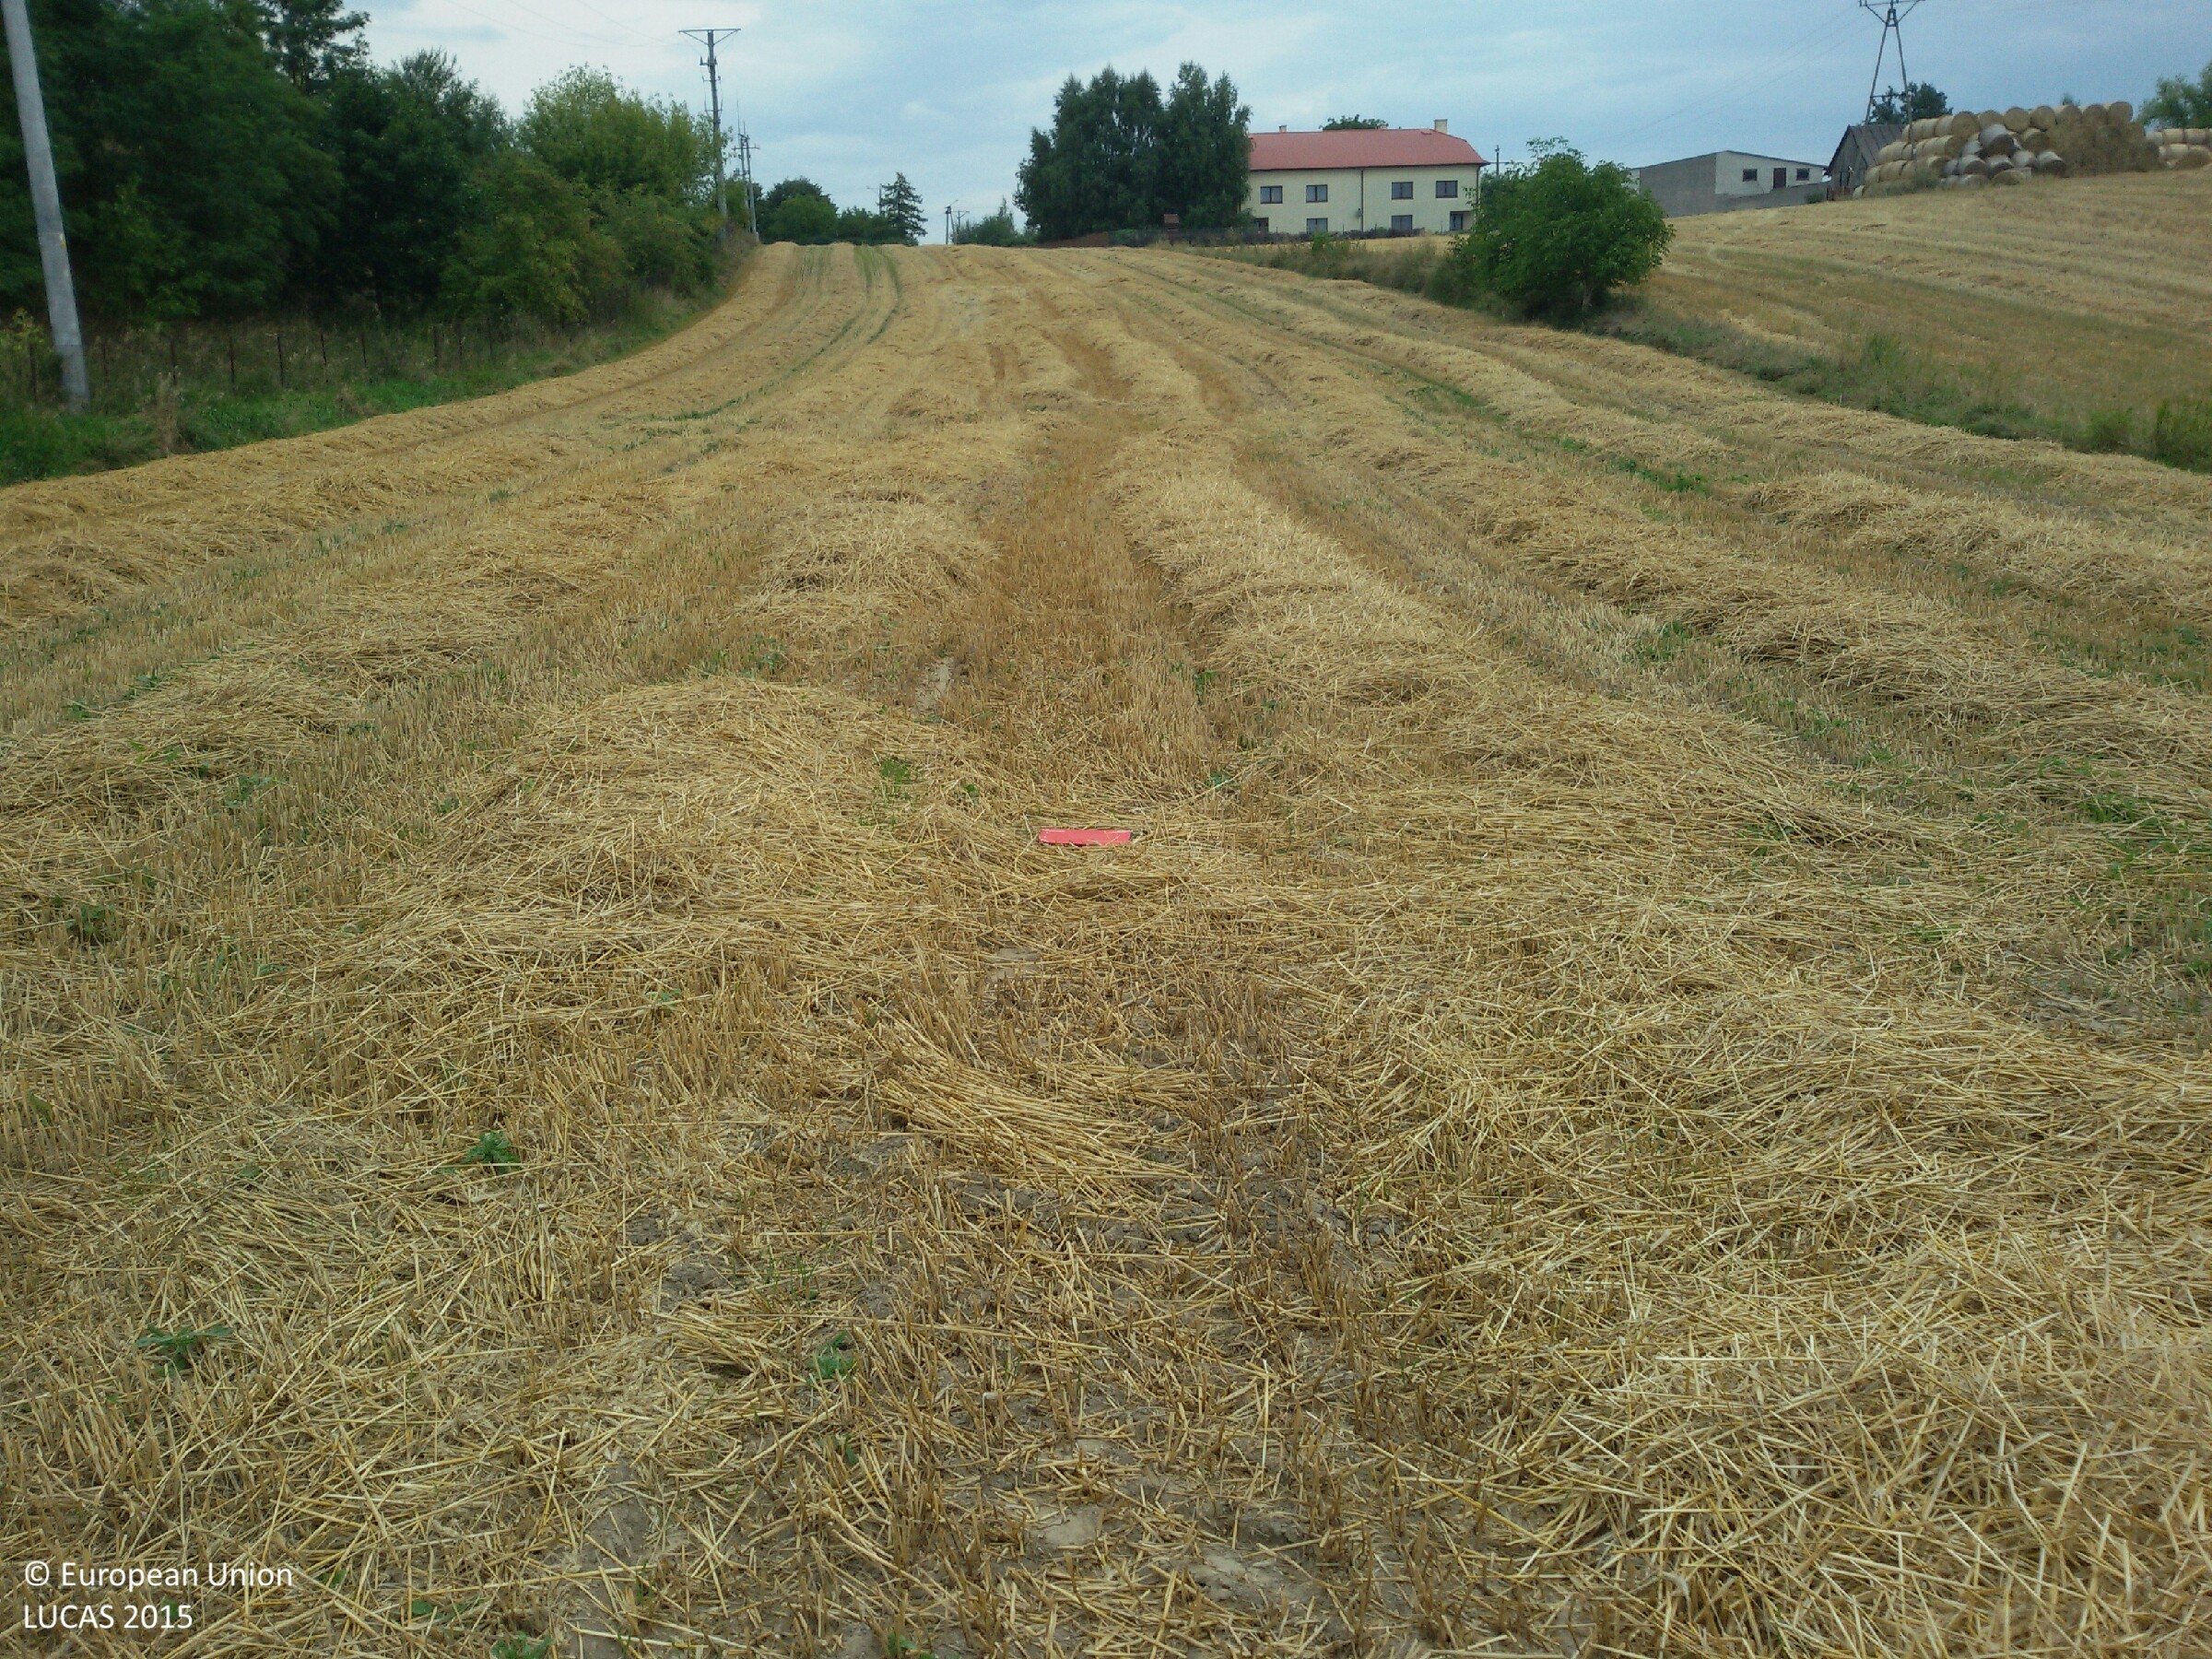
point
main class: Cropland
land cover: Triticale
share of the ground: > 75 %
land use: Agriculture (excluding fallow land and kitchen gardens)
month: August
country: PL
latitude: 50.7897
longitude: 21.4123
